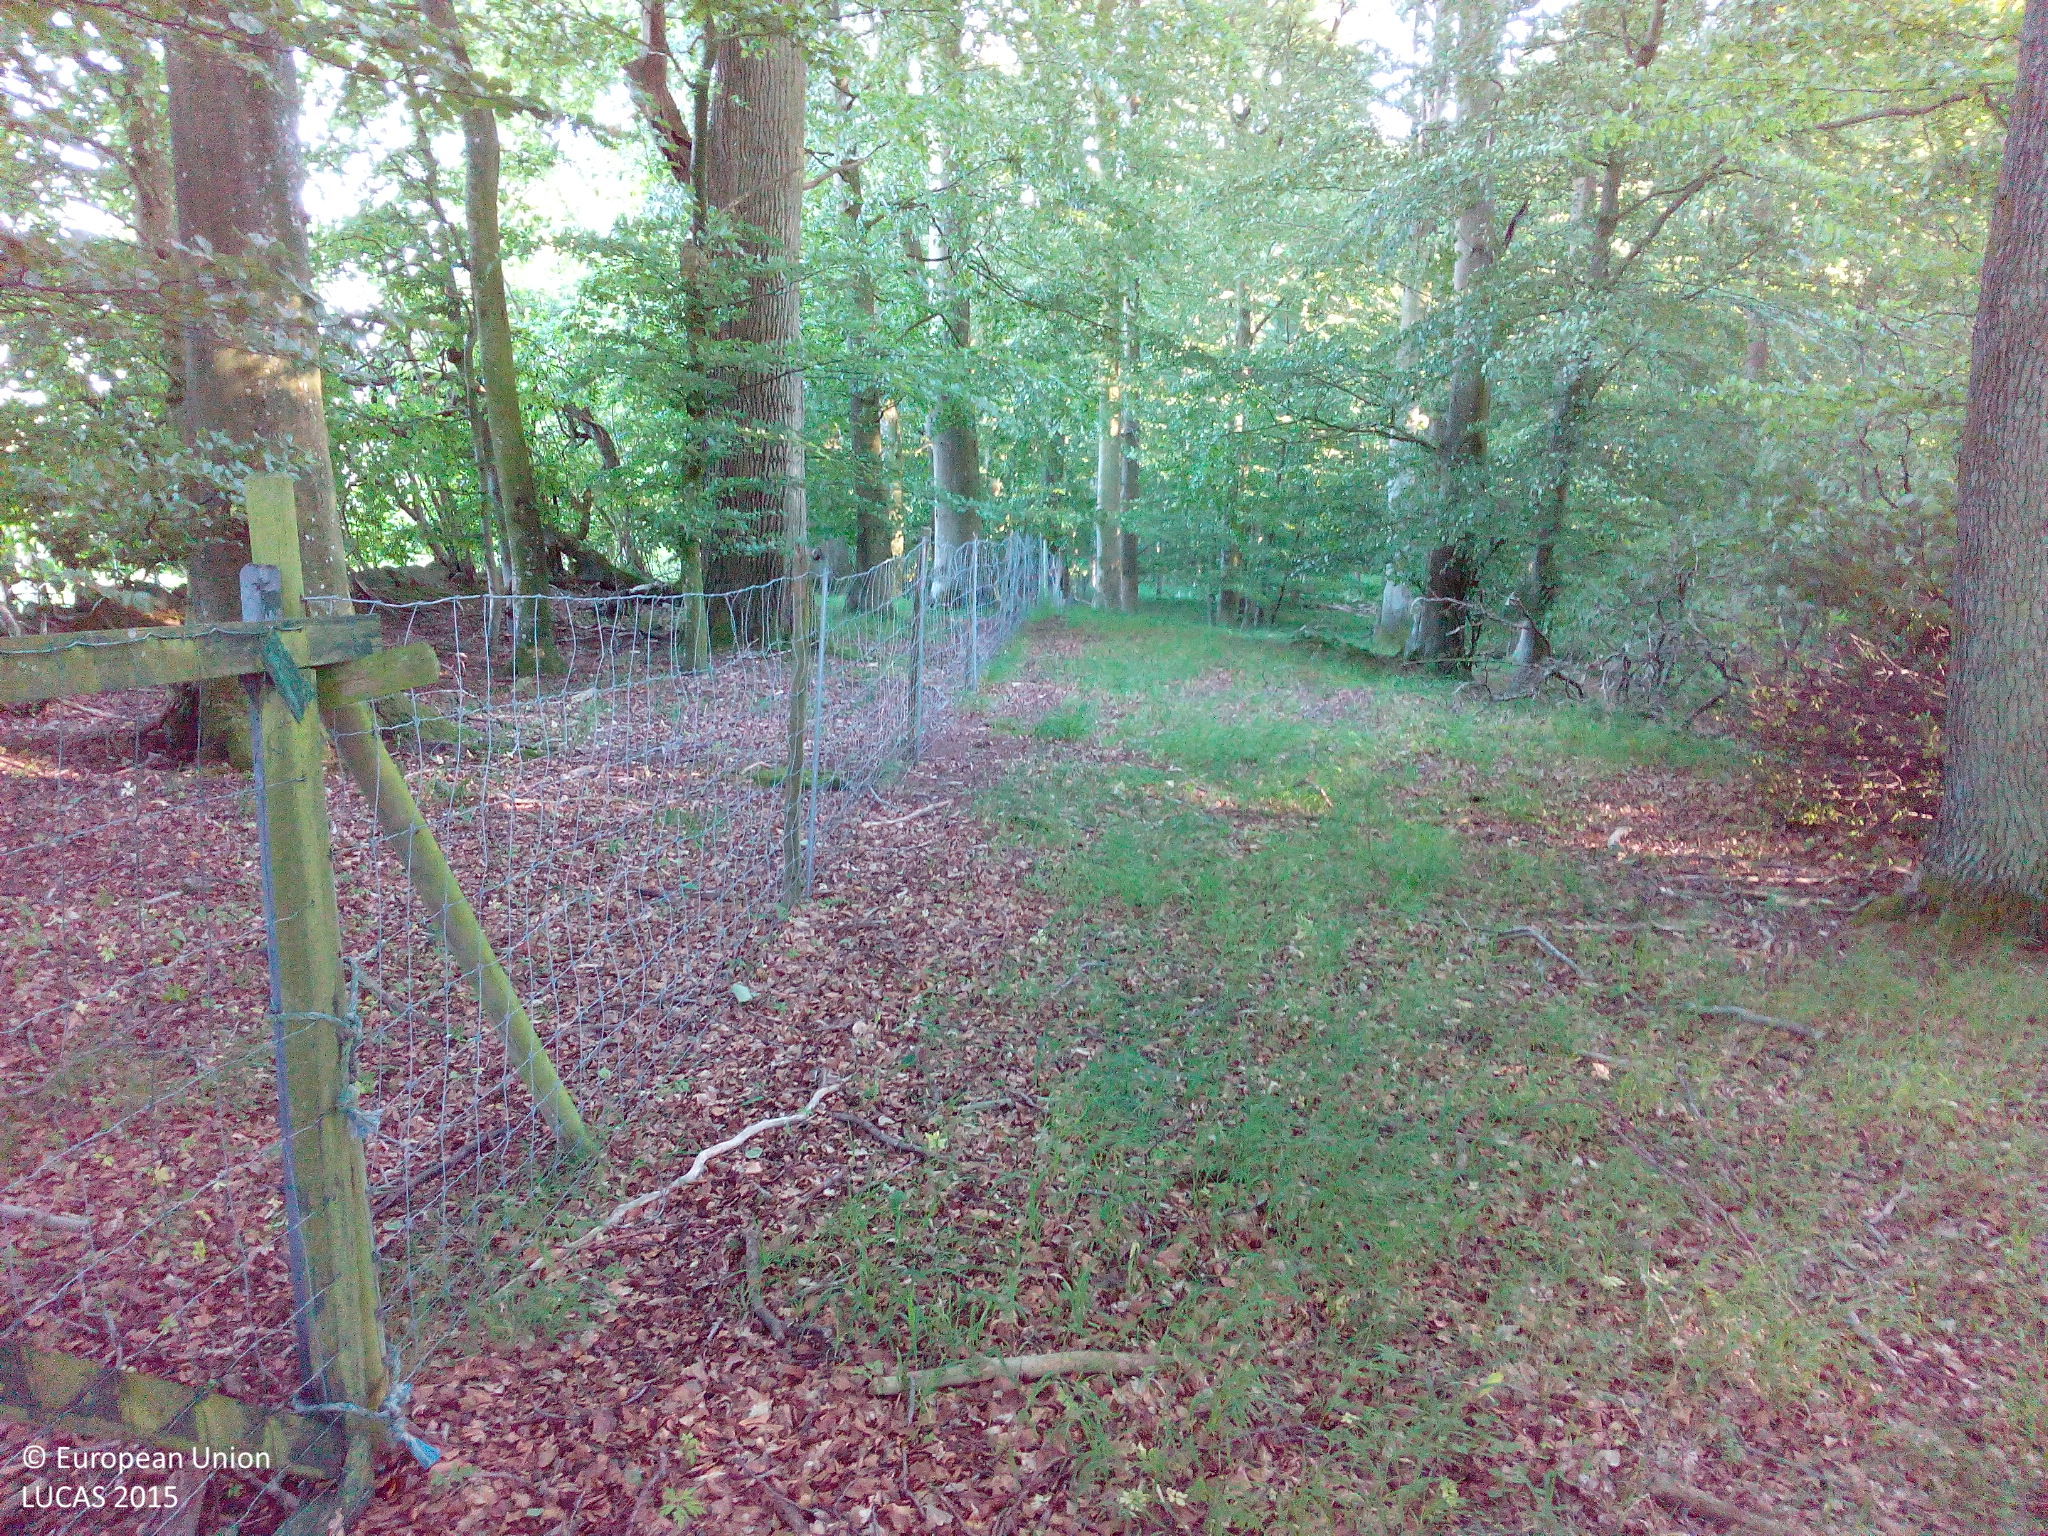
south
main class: Woodland
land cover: Broadleaved woodland
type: beech forest
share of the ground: > 75 %
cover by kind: broadleaved forest trees 90 %, herbaceous plants 10 %
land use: Forestry
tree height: > 5 m
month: July
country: DK
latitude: 55.2008
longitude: 12.0253
